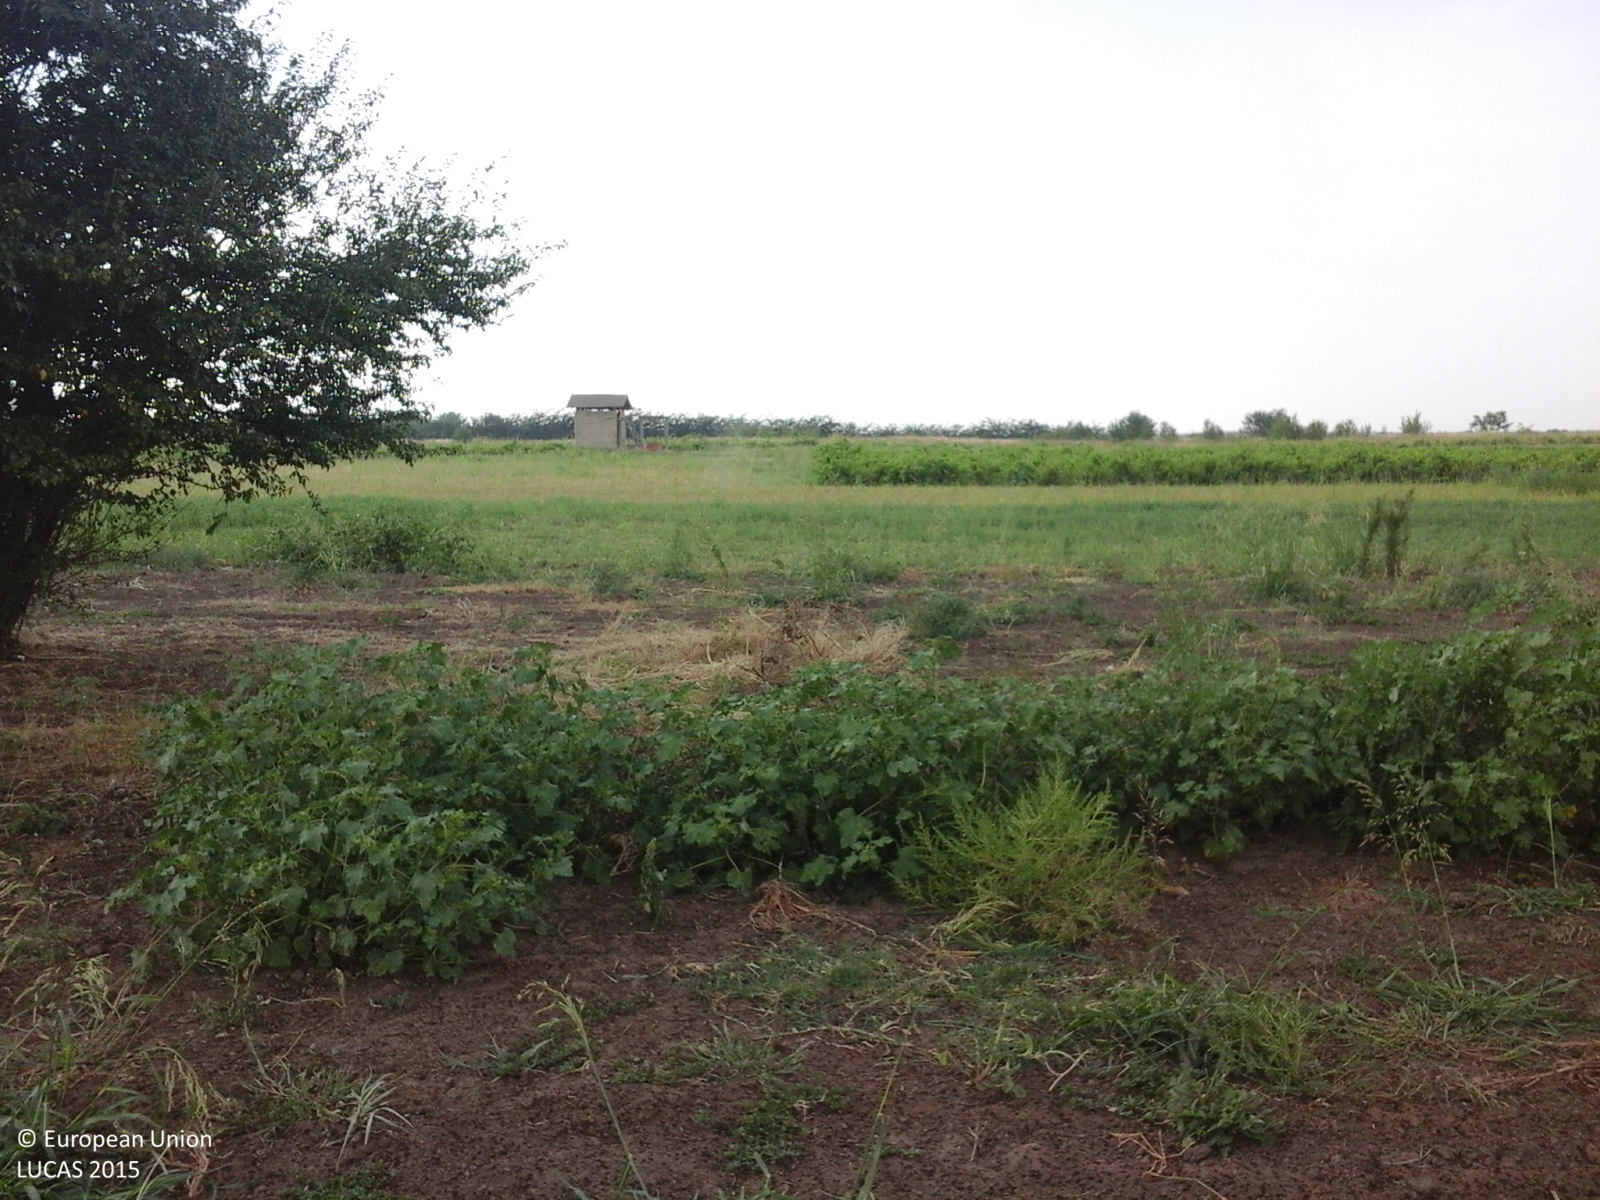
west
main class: Grassland
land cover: Spontaneously vegetated surfaces
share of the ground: 50 - 75 %
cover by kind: herbaceous plants 75 %, consolidated bare surface 25 %
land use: Agriculture (excluding fallow land and kitchen gardens)
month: August
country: RO
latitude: 43.9054
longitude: 23.0528
